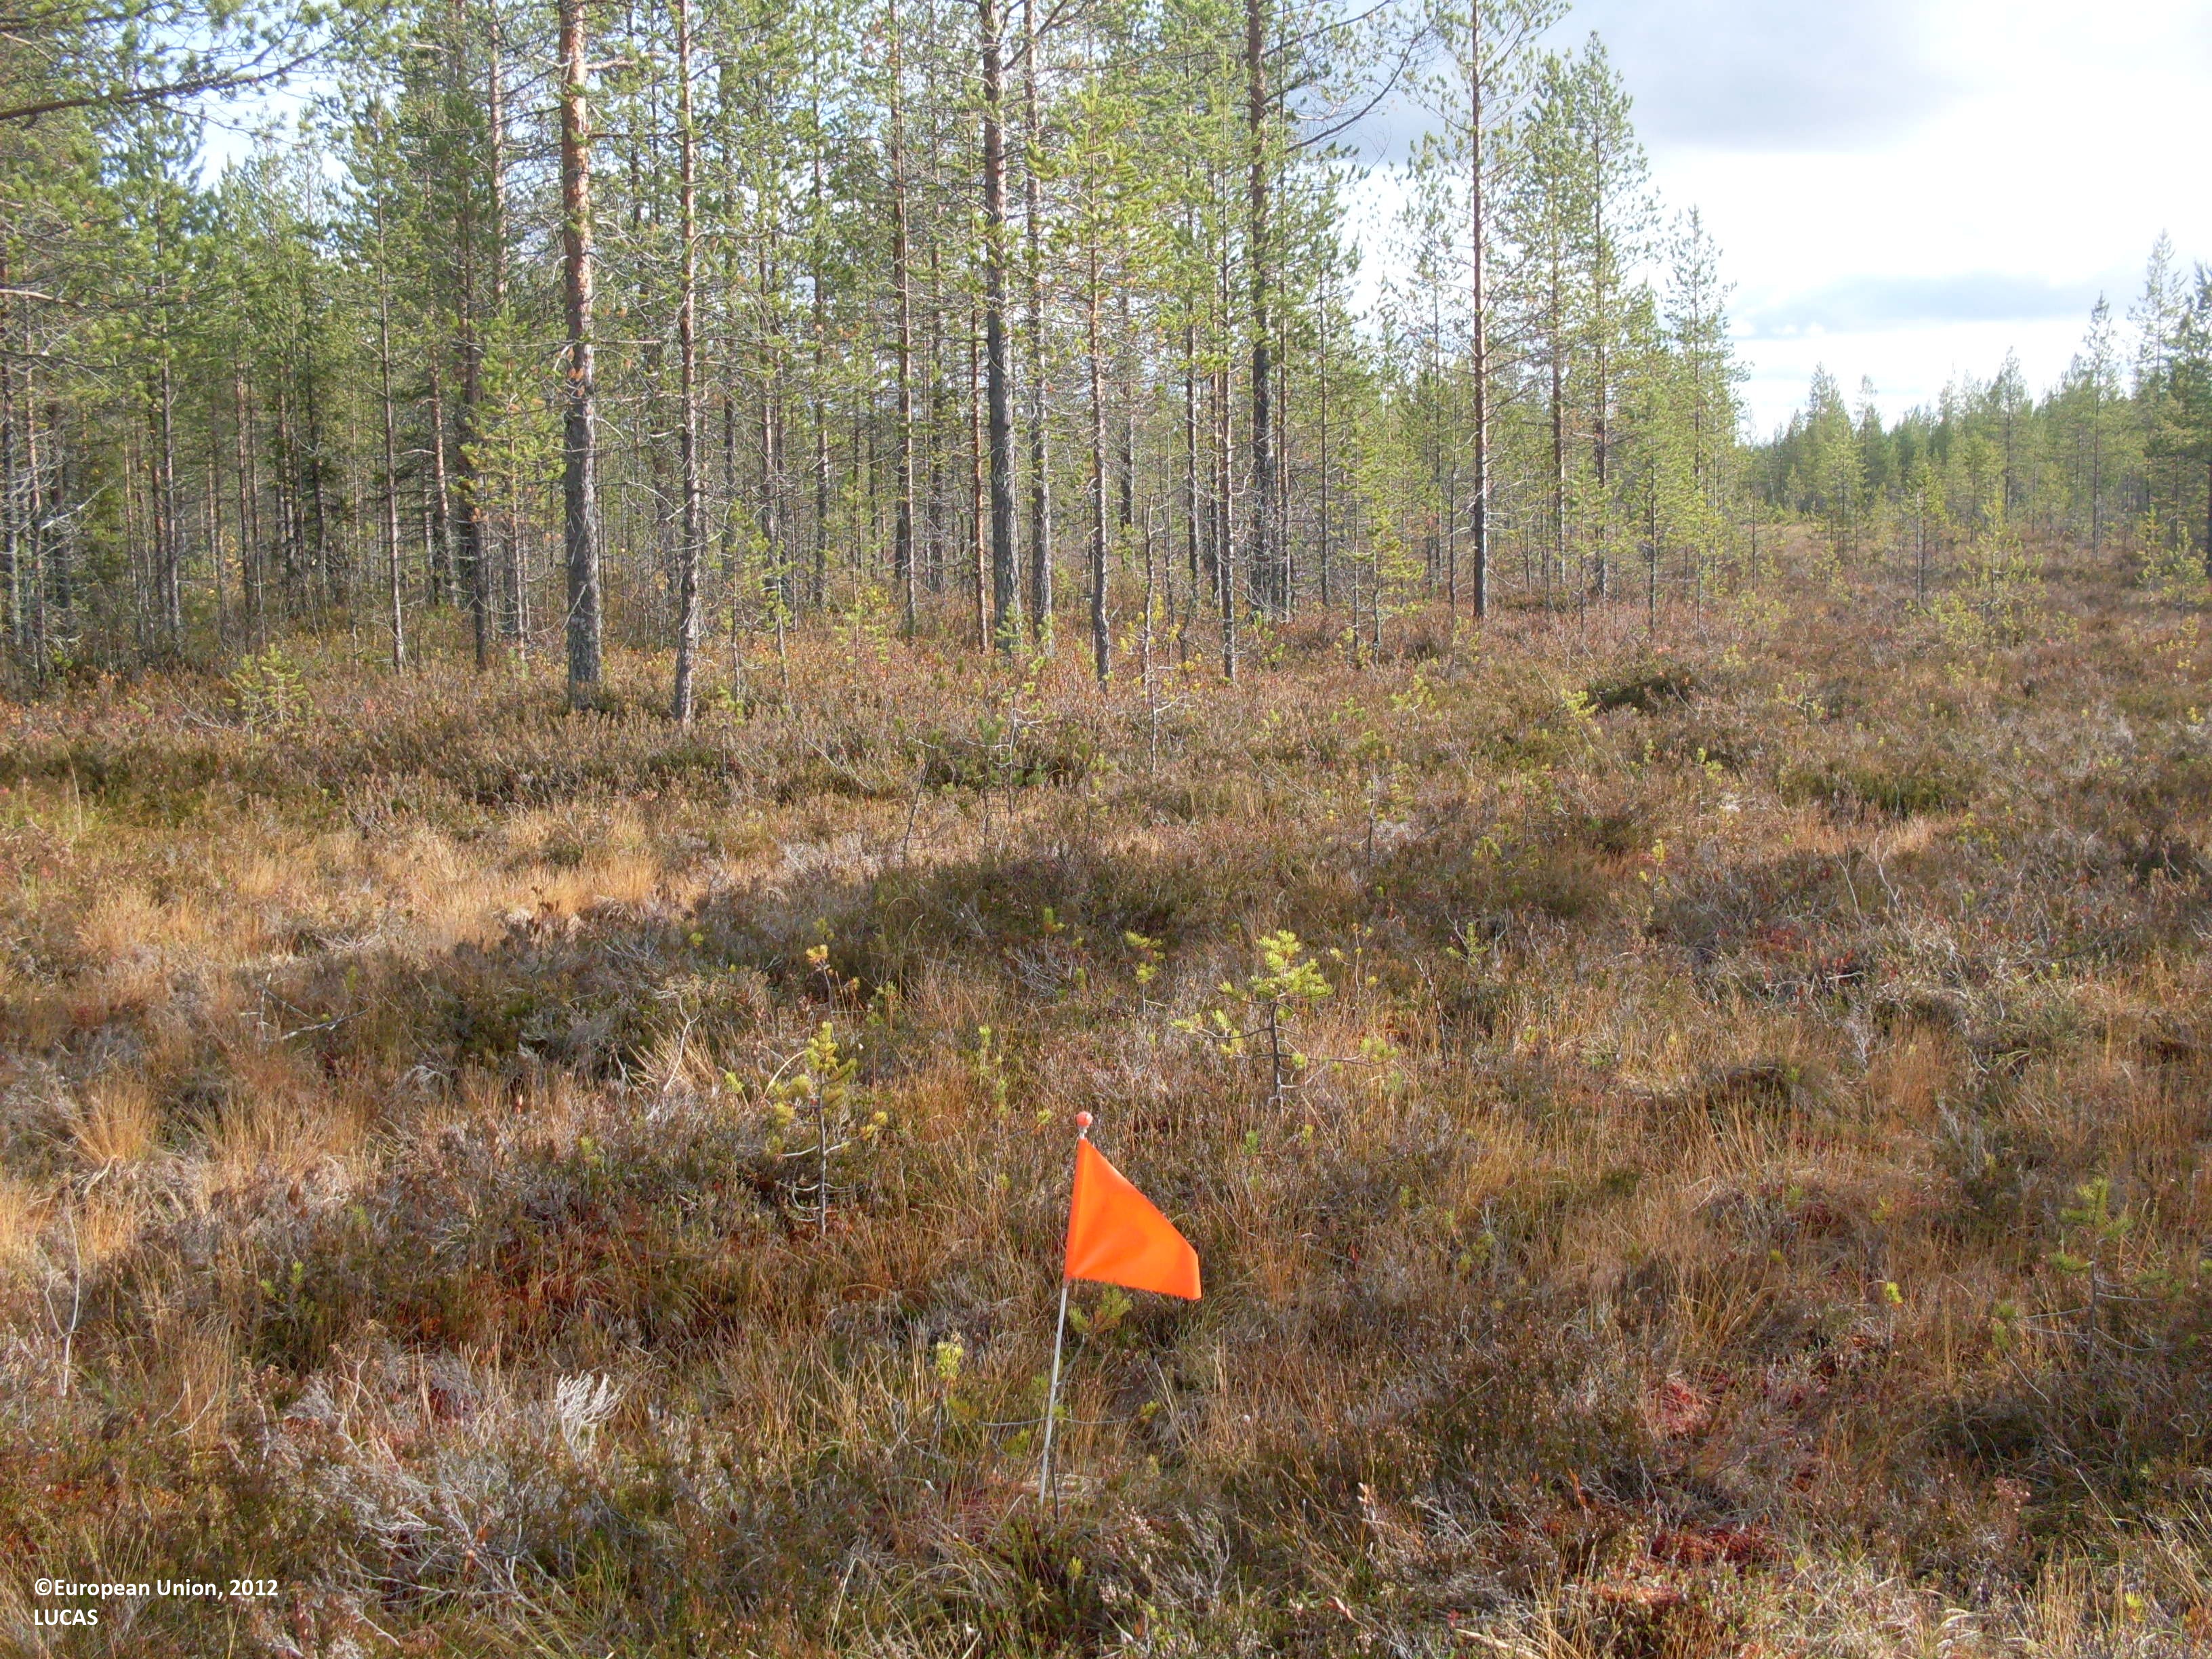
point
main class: Woodland
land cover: Pine dominated coniferous woodland
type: boreal forest
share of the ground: 10 - 25 %
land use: Forestry
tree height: > 5 m
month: September
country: FI
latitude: 64.7906
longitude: 29.4174
